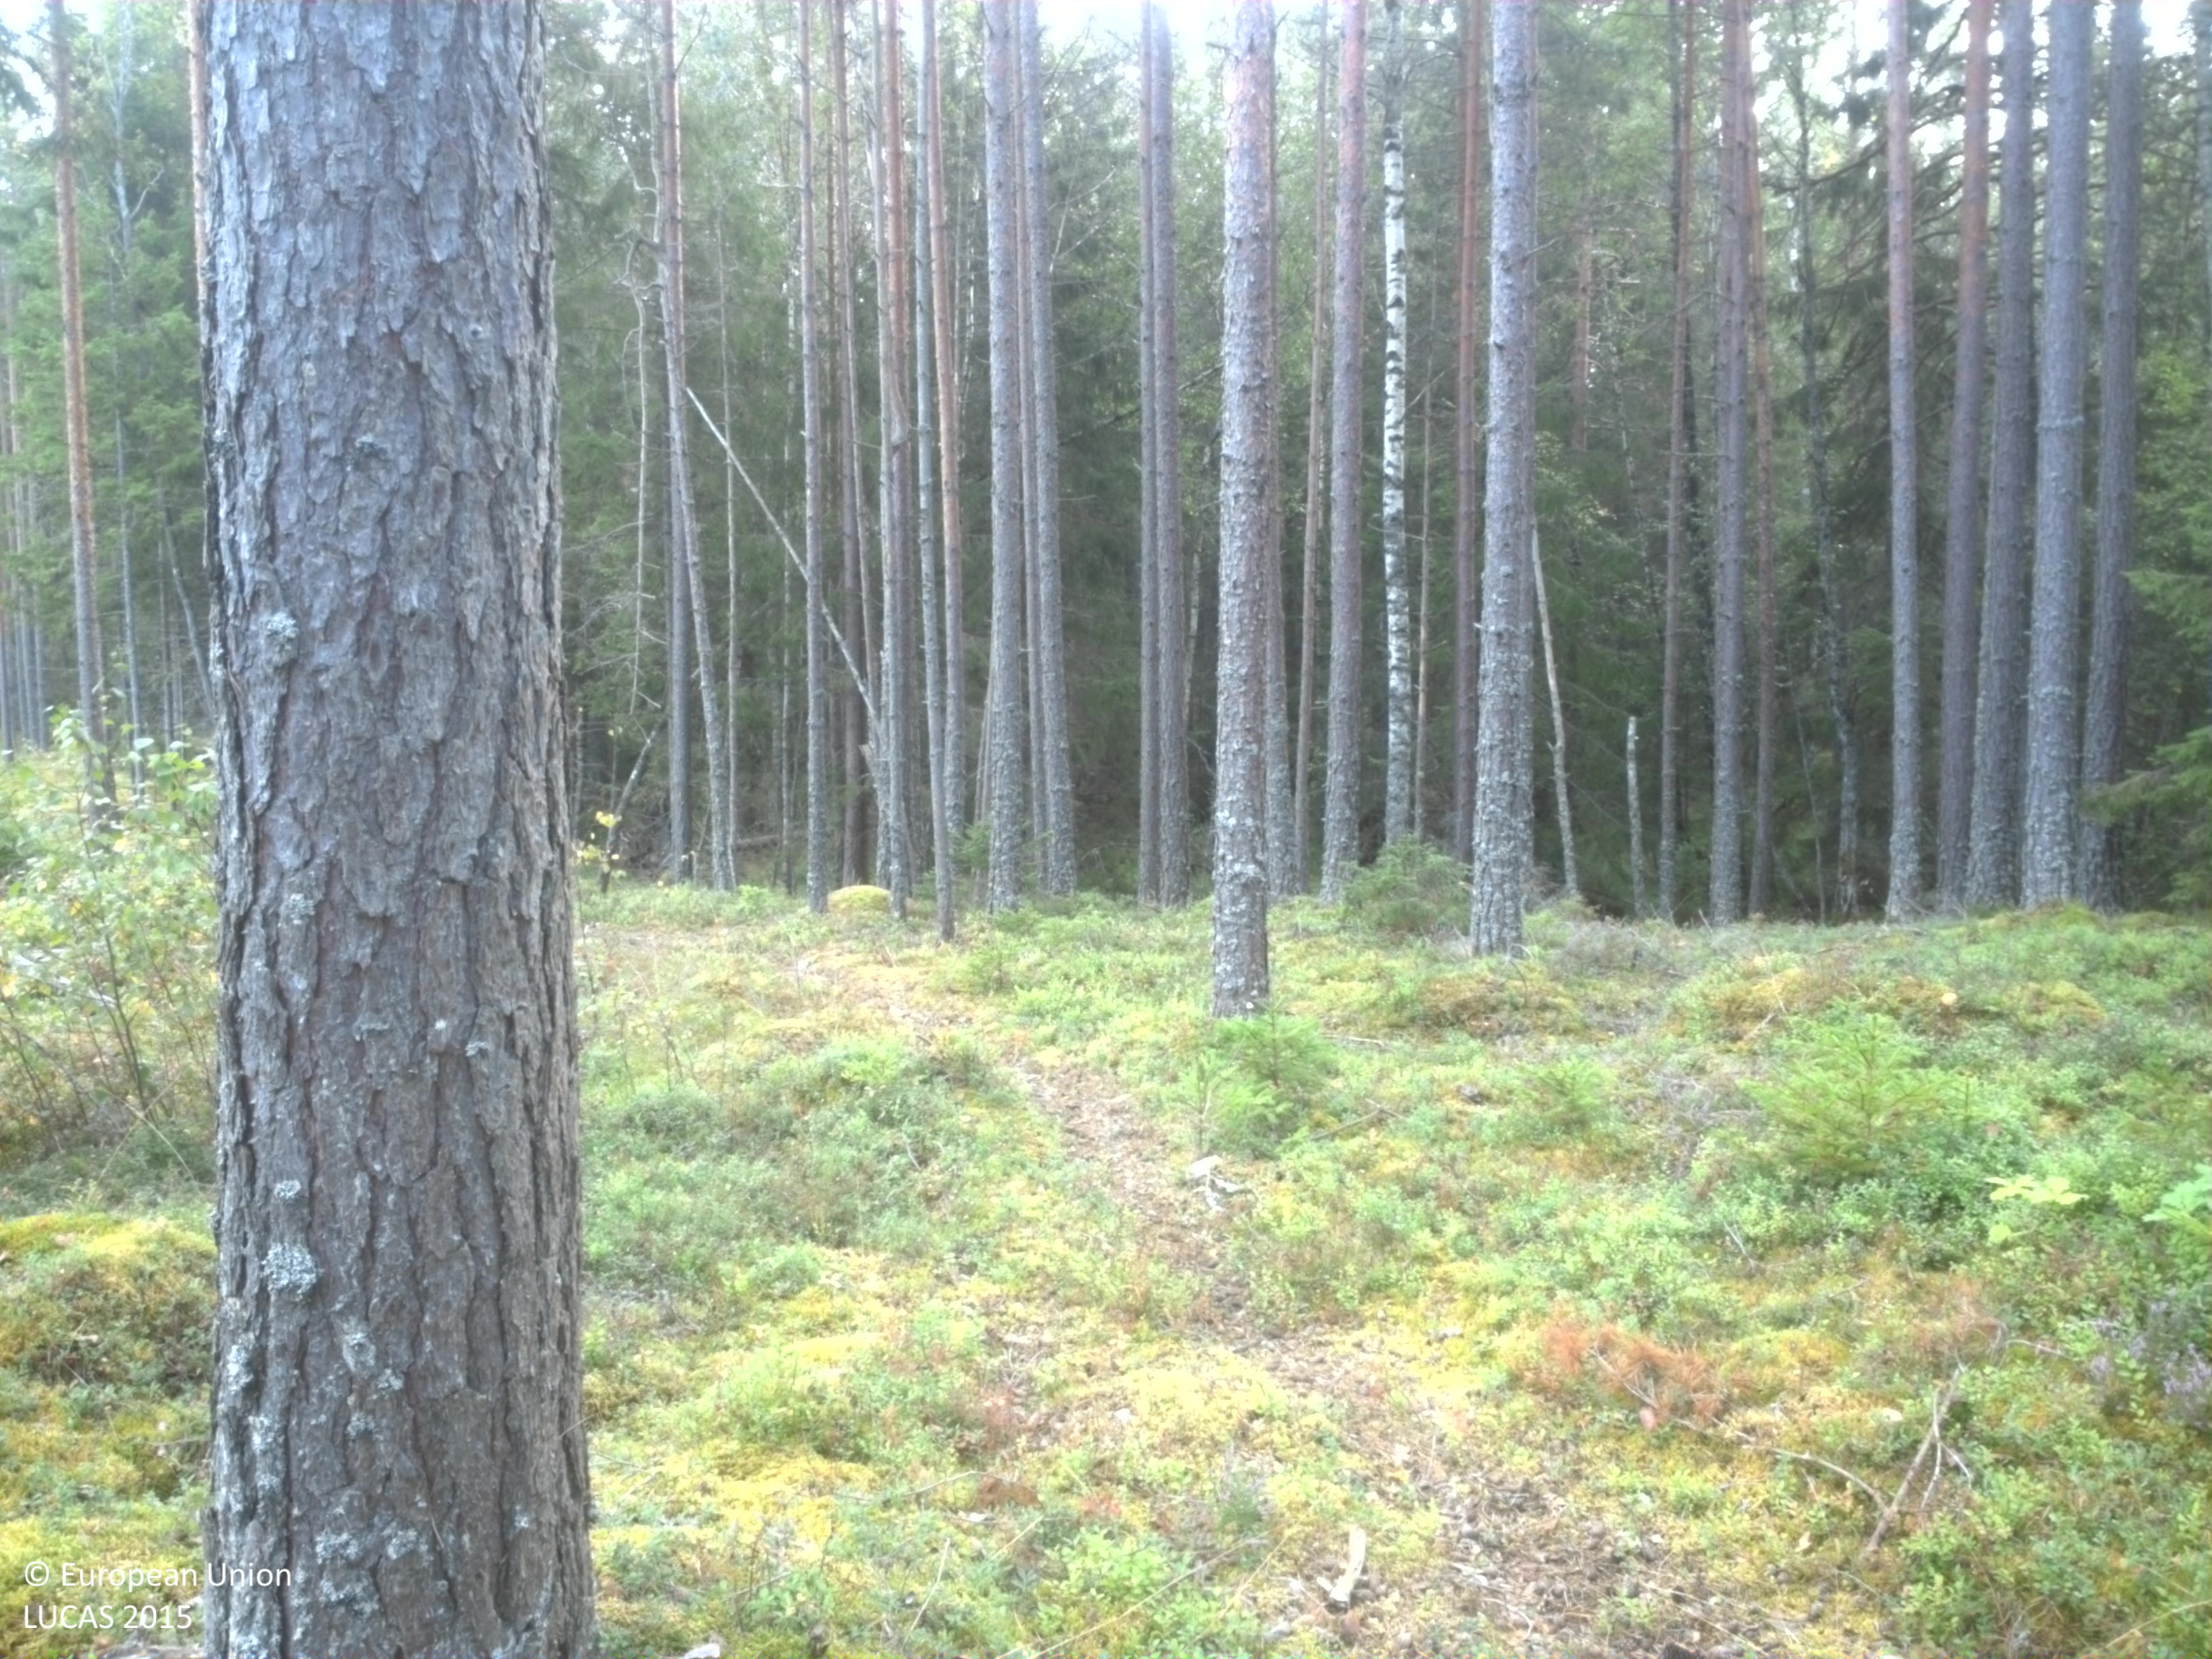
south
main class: Woodland
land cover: Pine dominated coniferous woodland
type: boreal forest
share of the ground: 50 - 75 %
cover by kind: coniferous forest trees 45 %, shrubs 30 %, lichens and mosses 20 %, broadleaved forest trees 5 %
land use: Forestry
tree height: > 5 m
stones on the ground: < 10 %
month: August
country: SE
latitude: 59.4551
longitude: 15.6188
